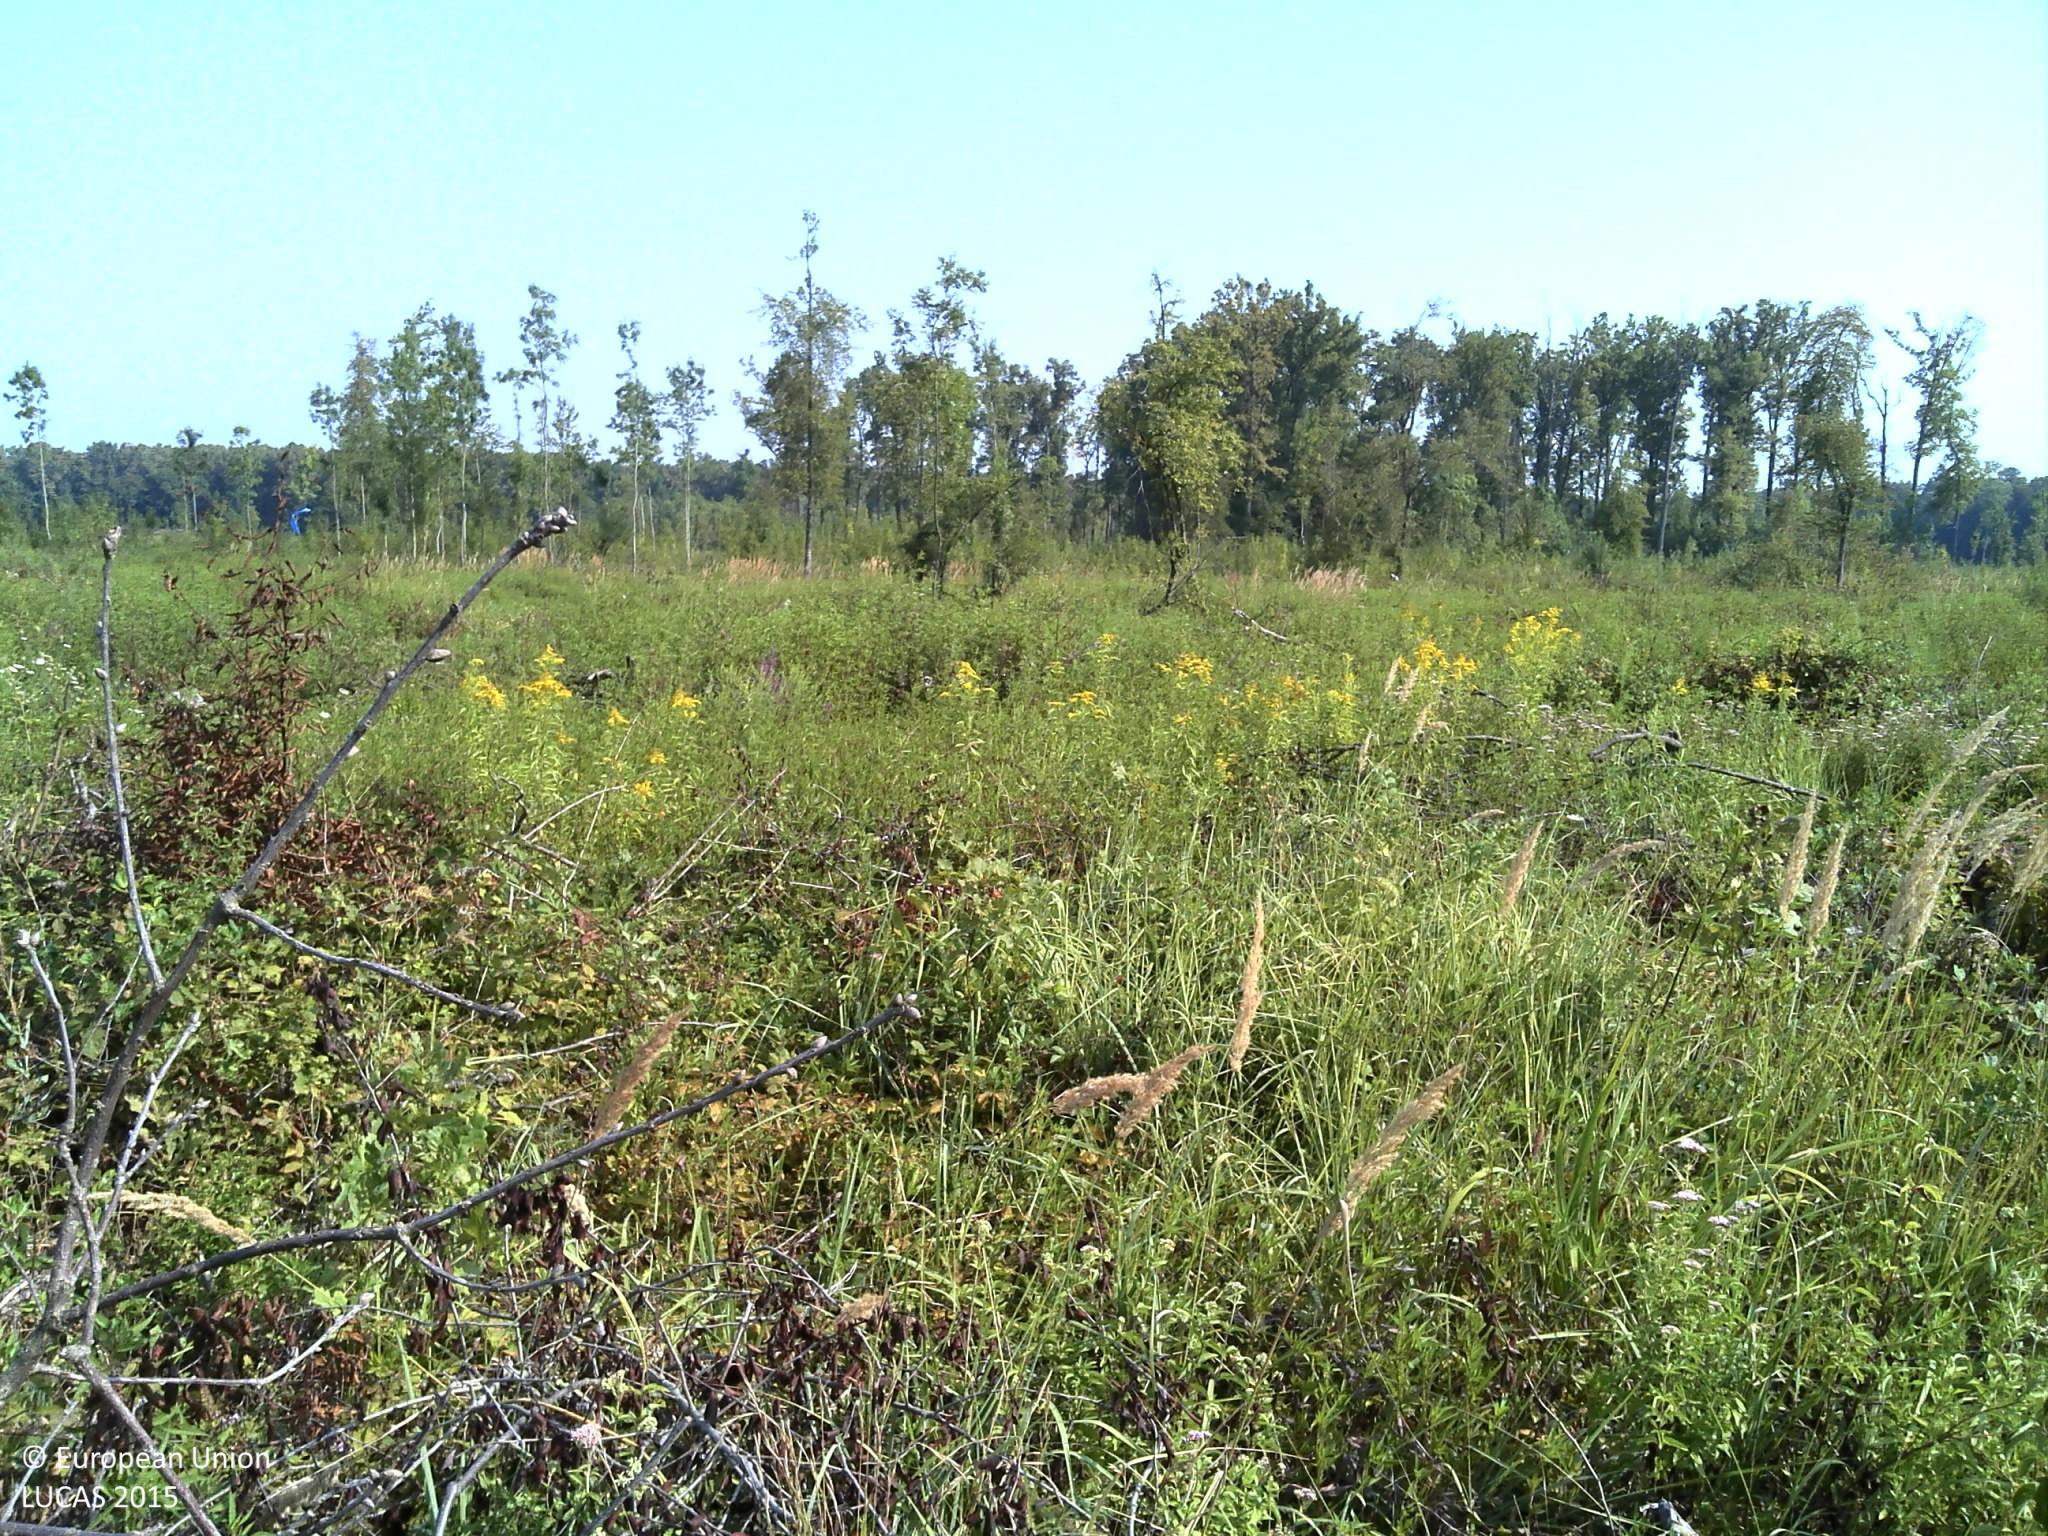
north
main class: Grassland
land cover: Spontaneously vegetated surfaces
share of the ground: > 75 %
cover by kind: herbaceous plants 100 %
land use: Semi-natural and natural areas not in use
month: August
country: HR
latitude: 45.0990
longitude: 18.8129
